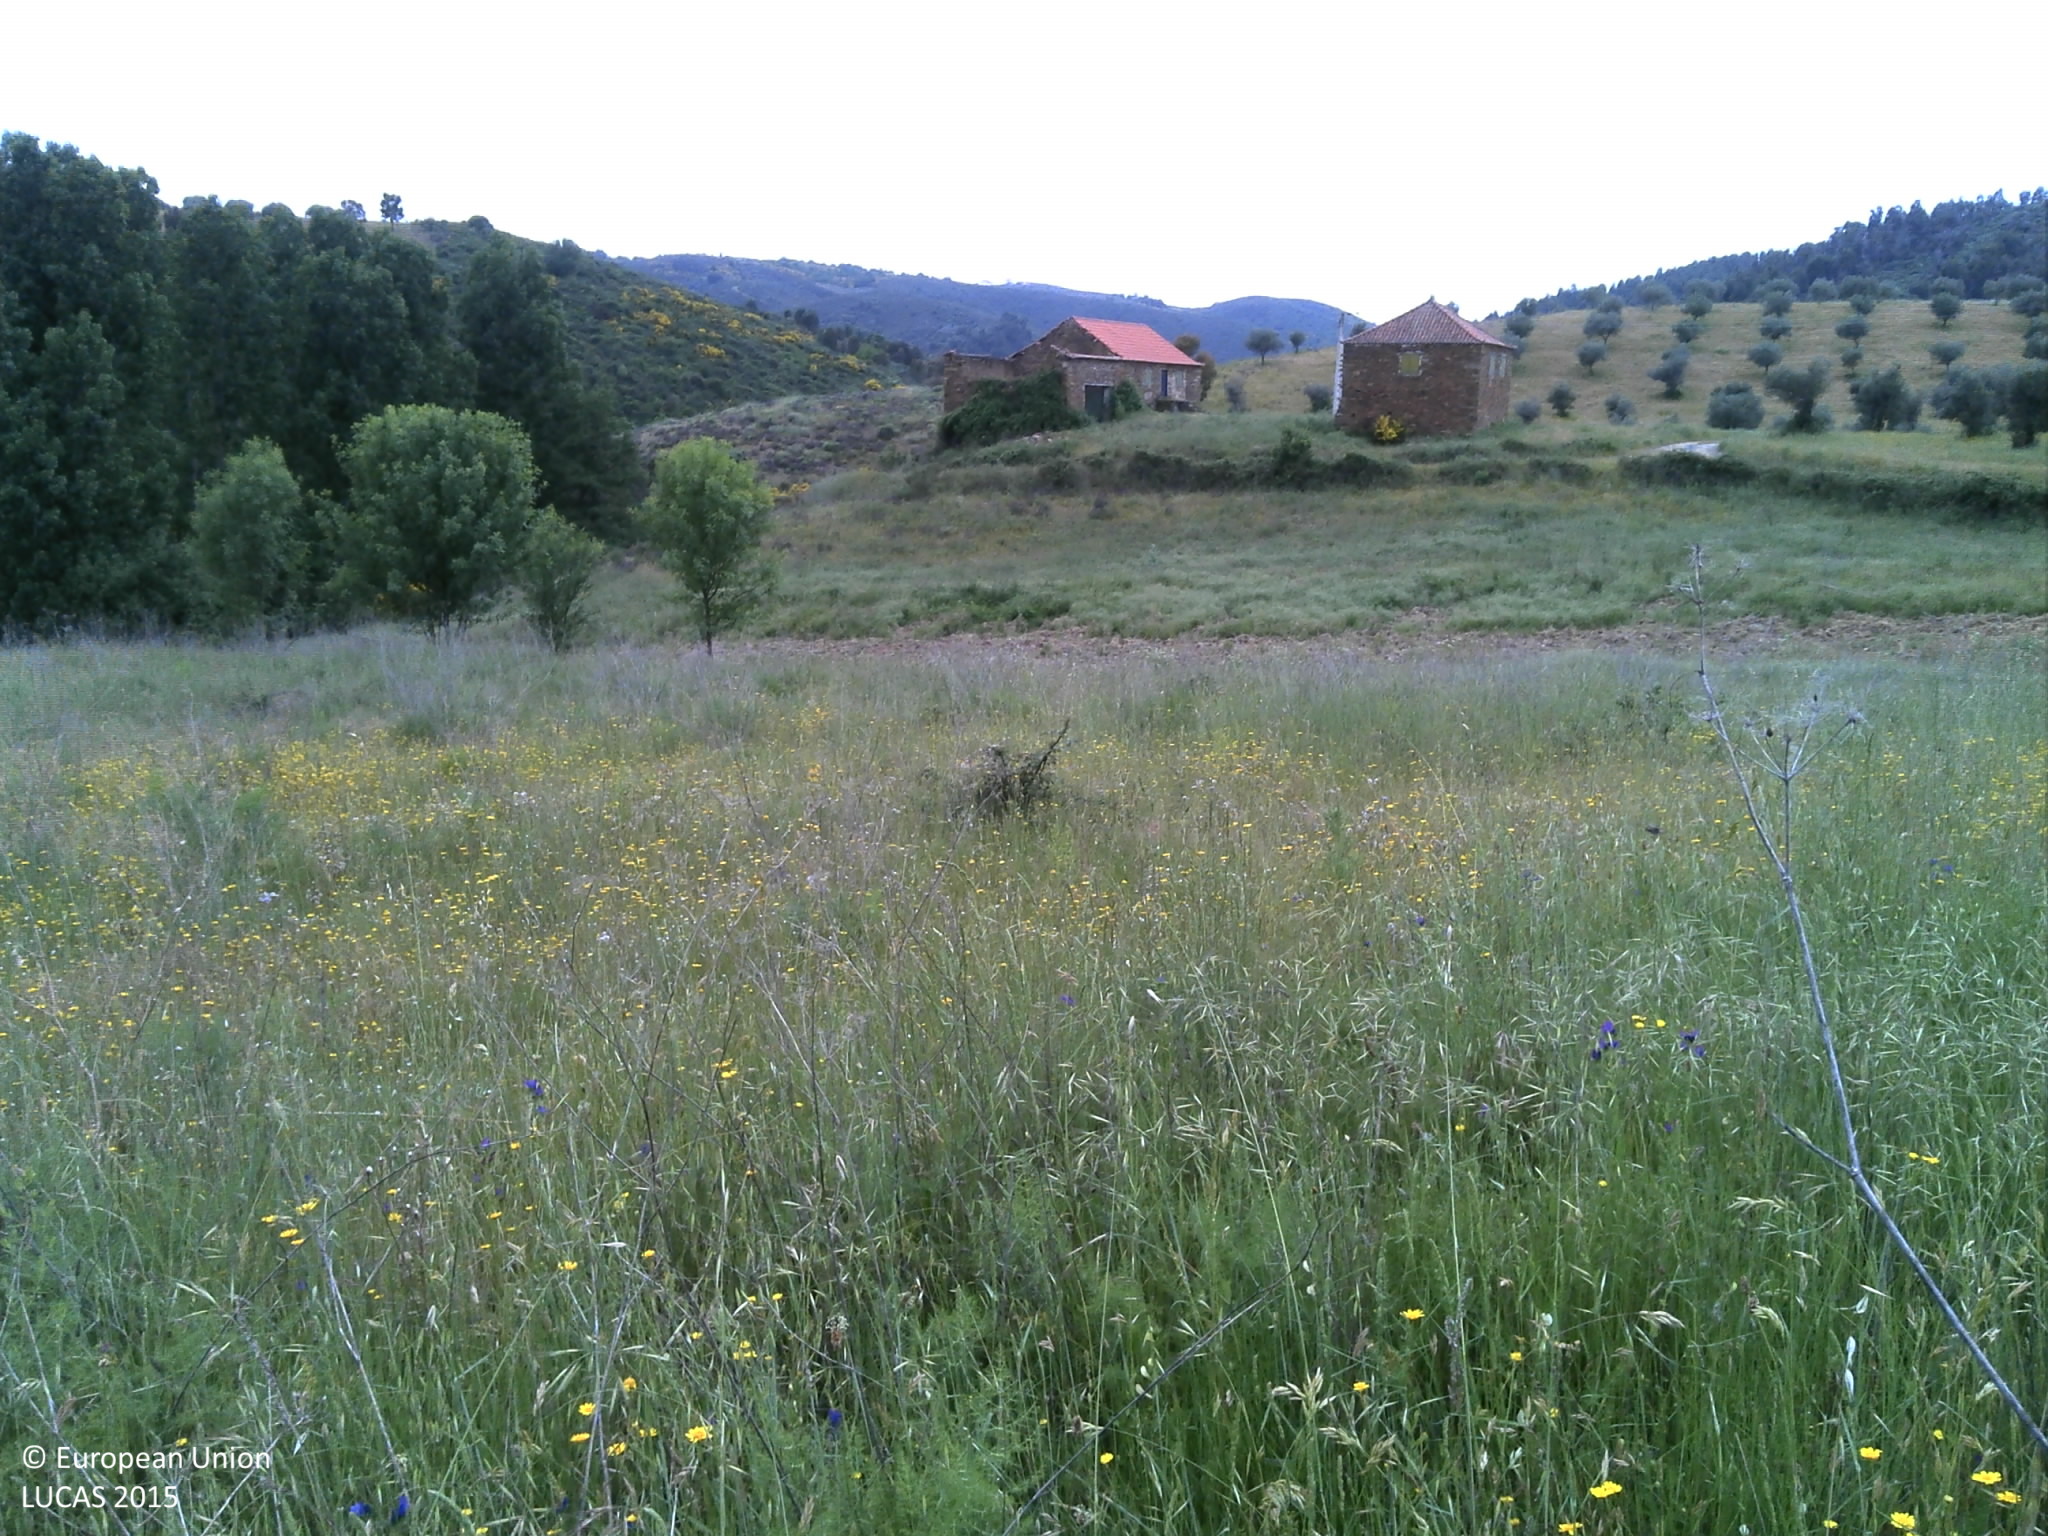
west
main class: Grassland
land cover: Grassland with sparse tree/shrub cover
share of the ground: > 75 %
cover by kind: herbaceous plants 90 %, broadleaved forest trees 5 %, unconsolidated bare surface 5 %
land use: Agriculture (excluding fallow land and kitchen gardens)
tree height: > 5 m
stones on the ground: 10 - 25 %
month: May
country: PT
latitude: 41.6367
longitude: -7.0567
